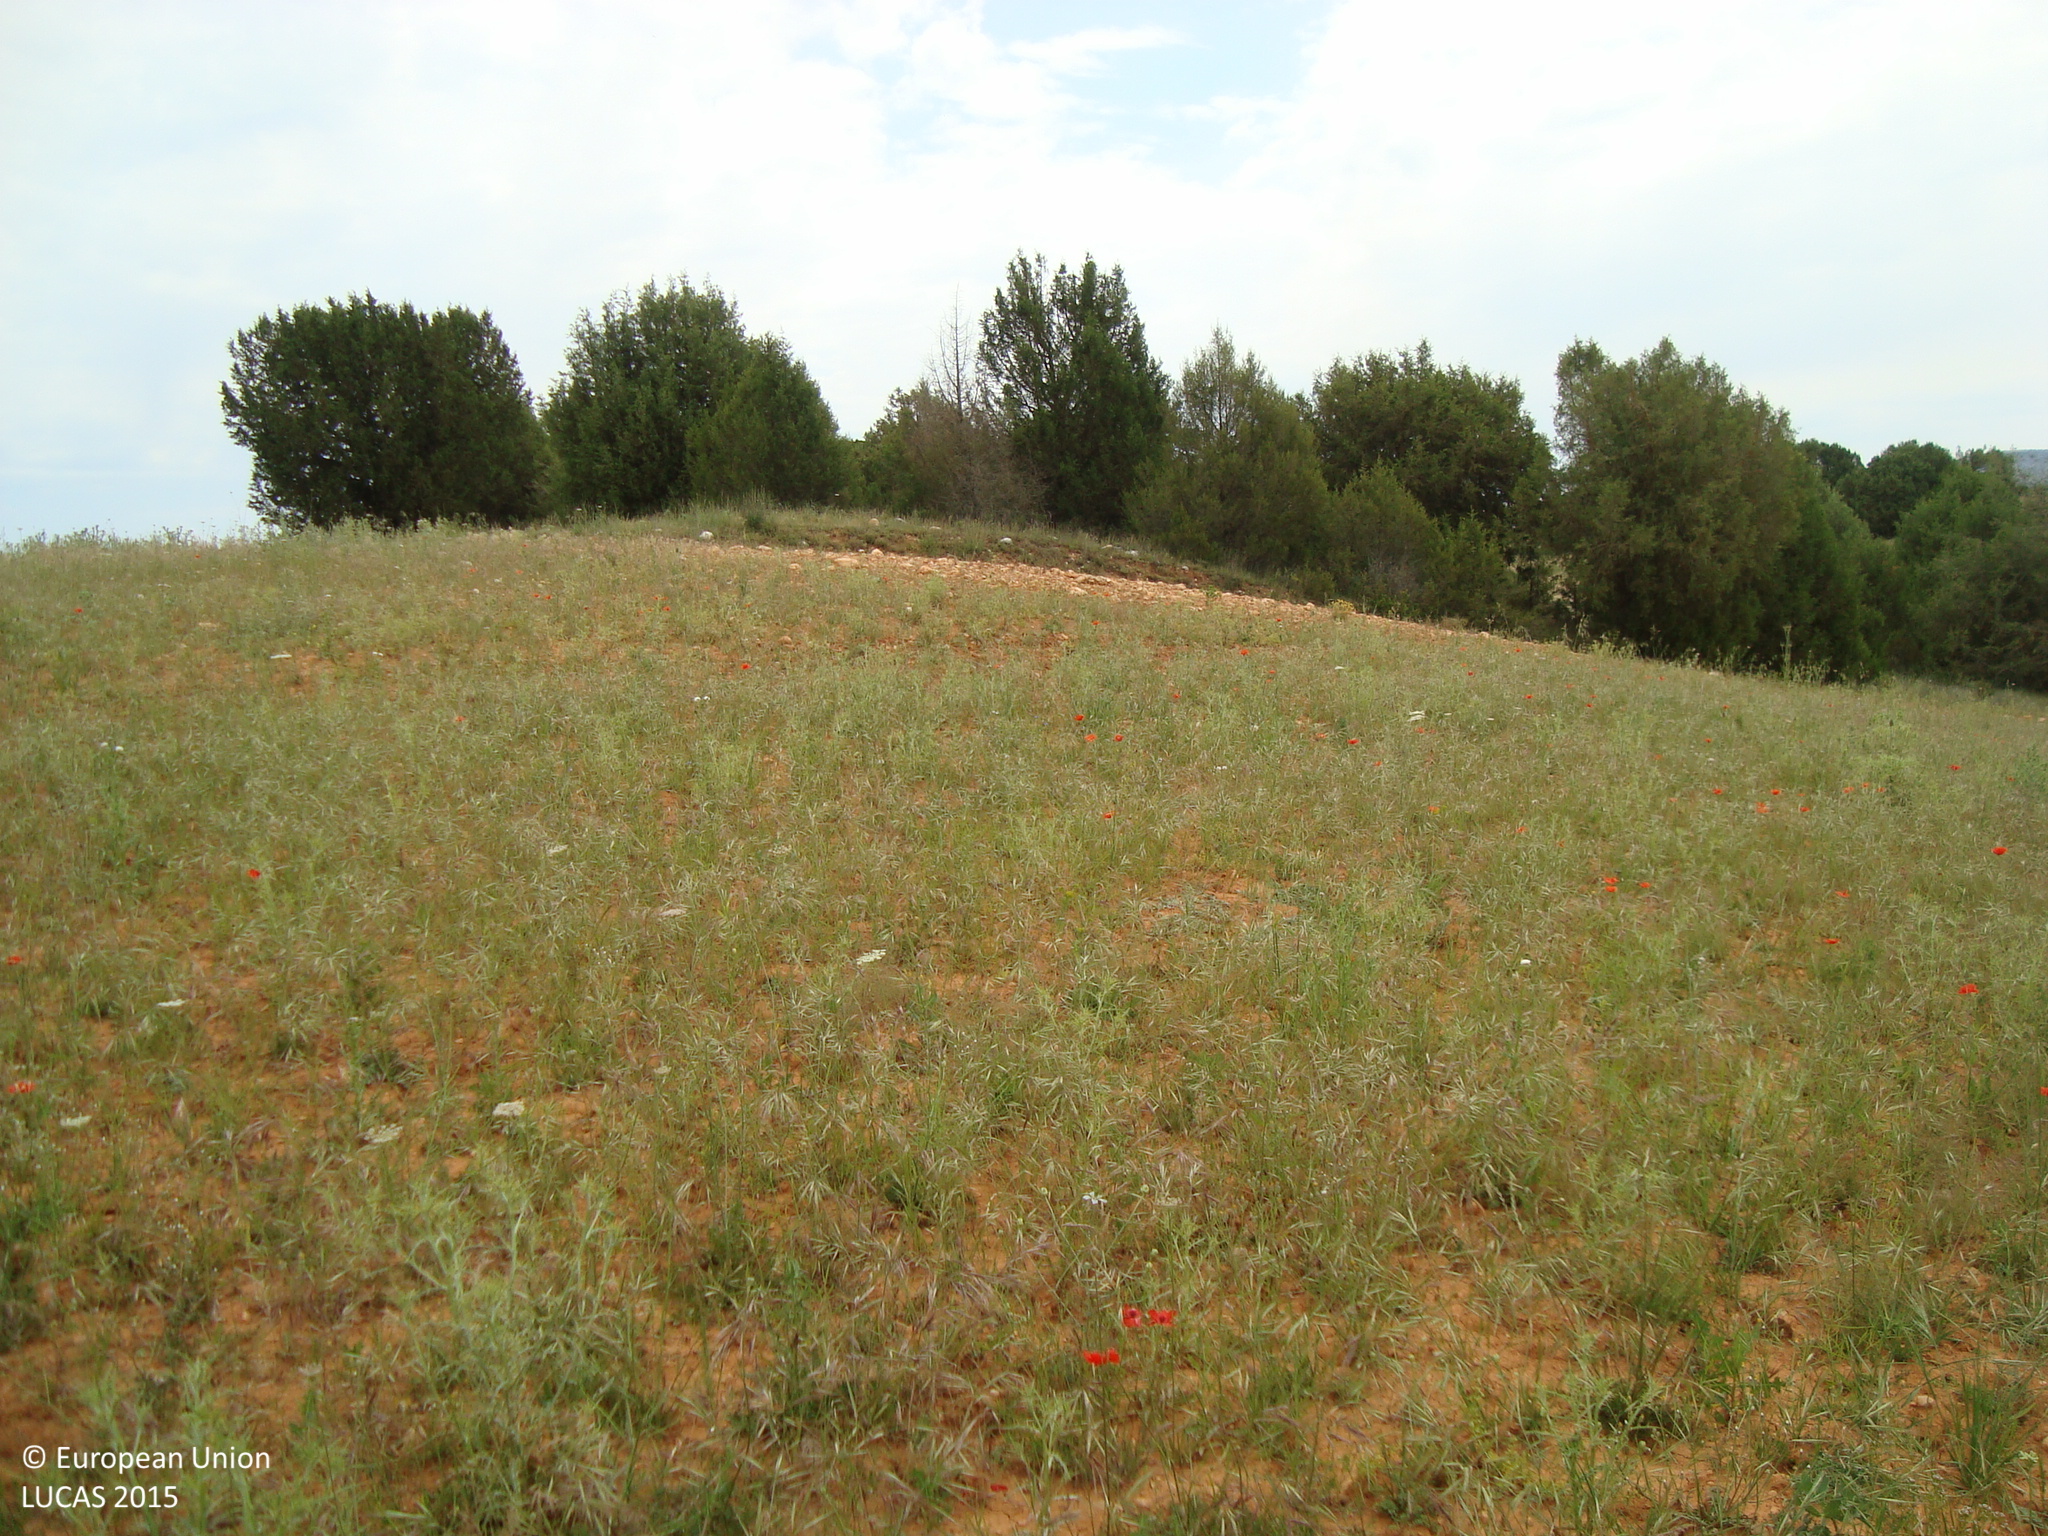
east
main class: Grassland
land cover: Spontaneously vegetated surfaces
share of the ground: 25 - 50 %
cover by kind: unconsolidated bare surface 60 %, herbaceous plants 40 %
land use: Fallow land
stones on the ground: < 10 %
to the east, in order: Spontaneously vegetated surfaces; Pine dominated coniferous woodland; Common wheat
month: June
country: ES
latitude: 41.9898
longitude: -3.5864
